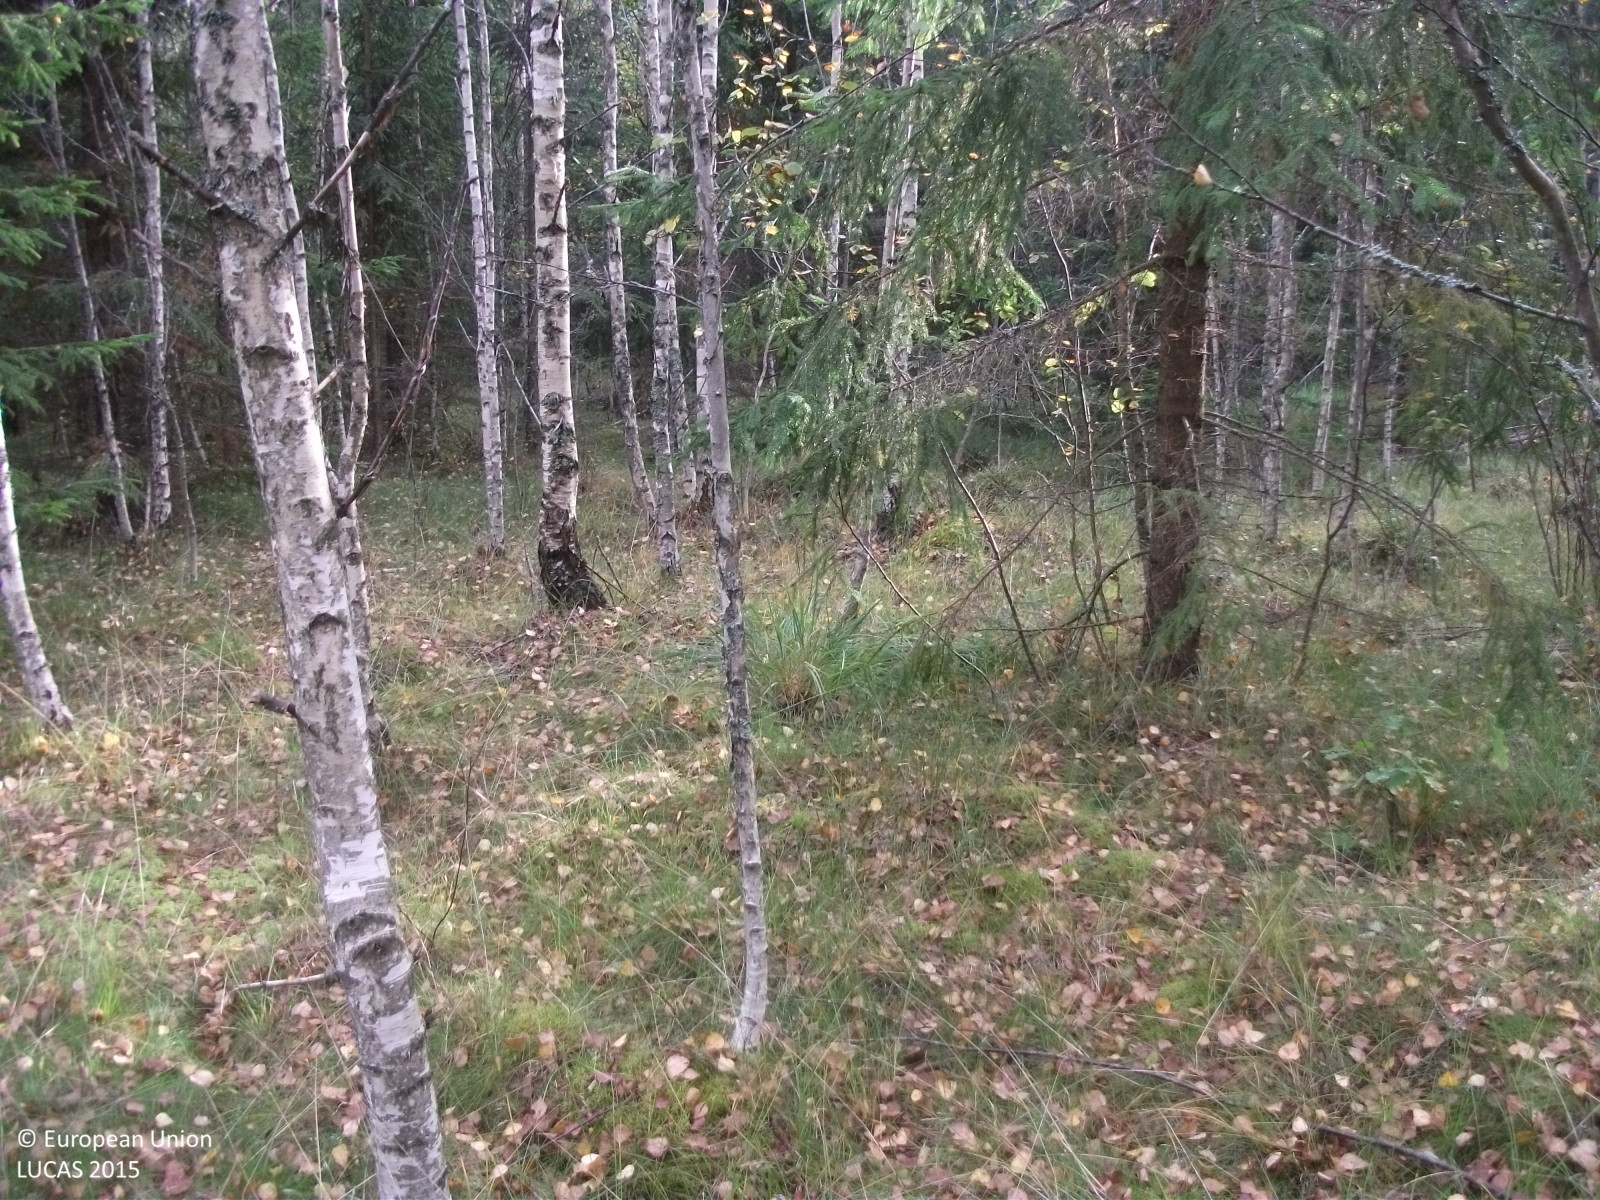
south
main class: Woodland
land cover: Spruce dominated mixed woodland
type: hemiboreal forest and nemoral coniferous forest and mixed broadleaved-coniferous forest
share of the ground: > 75 %
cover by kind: broadleaved forest trees 55 %, coniferous forest trees 30 %, herbaceous plants 15 %
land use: Forestry
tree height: > 5 m
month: September
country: LV
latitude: 57.8125
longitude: 24.8241
